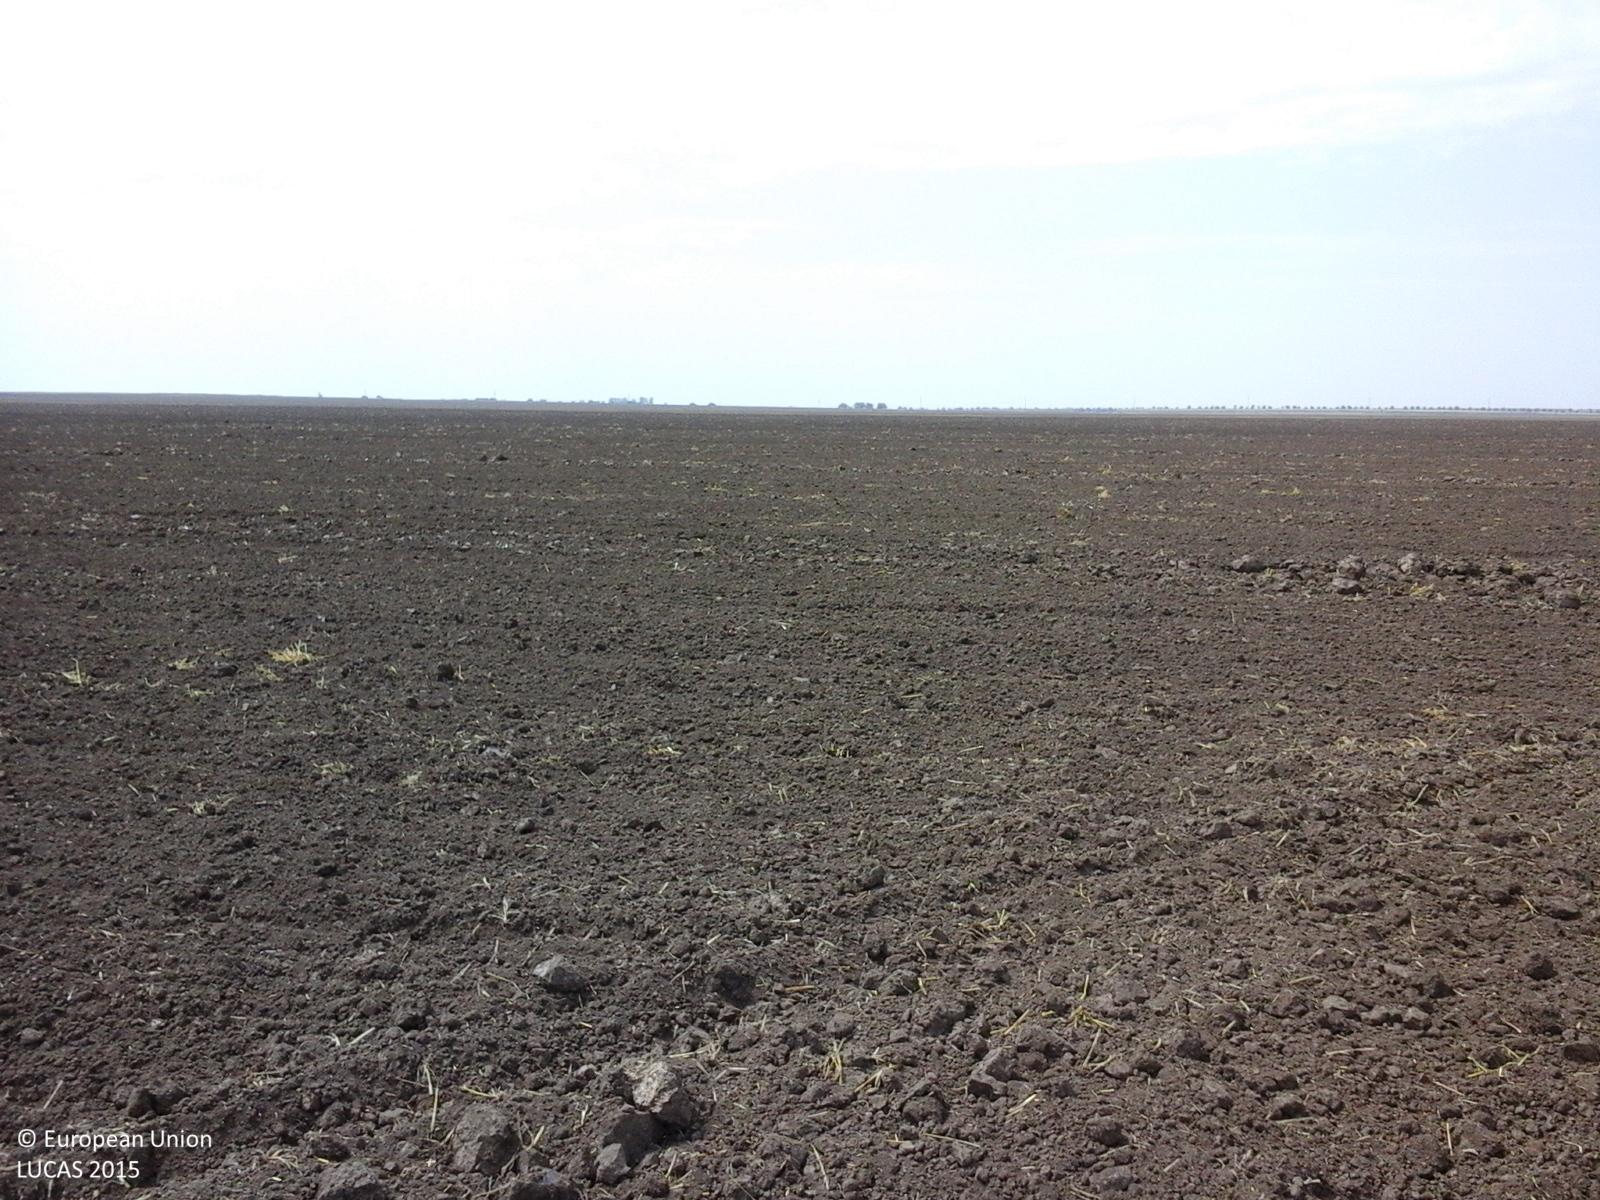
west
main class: Cropland
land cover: Common wheat
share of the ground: < 10 %
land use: Agriculture (excluding fallow land and kitchen gardens)
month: August
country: RO
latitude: 43.9229
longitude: 28.4099
